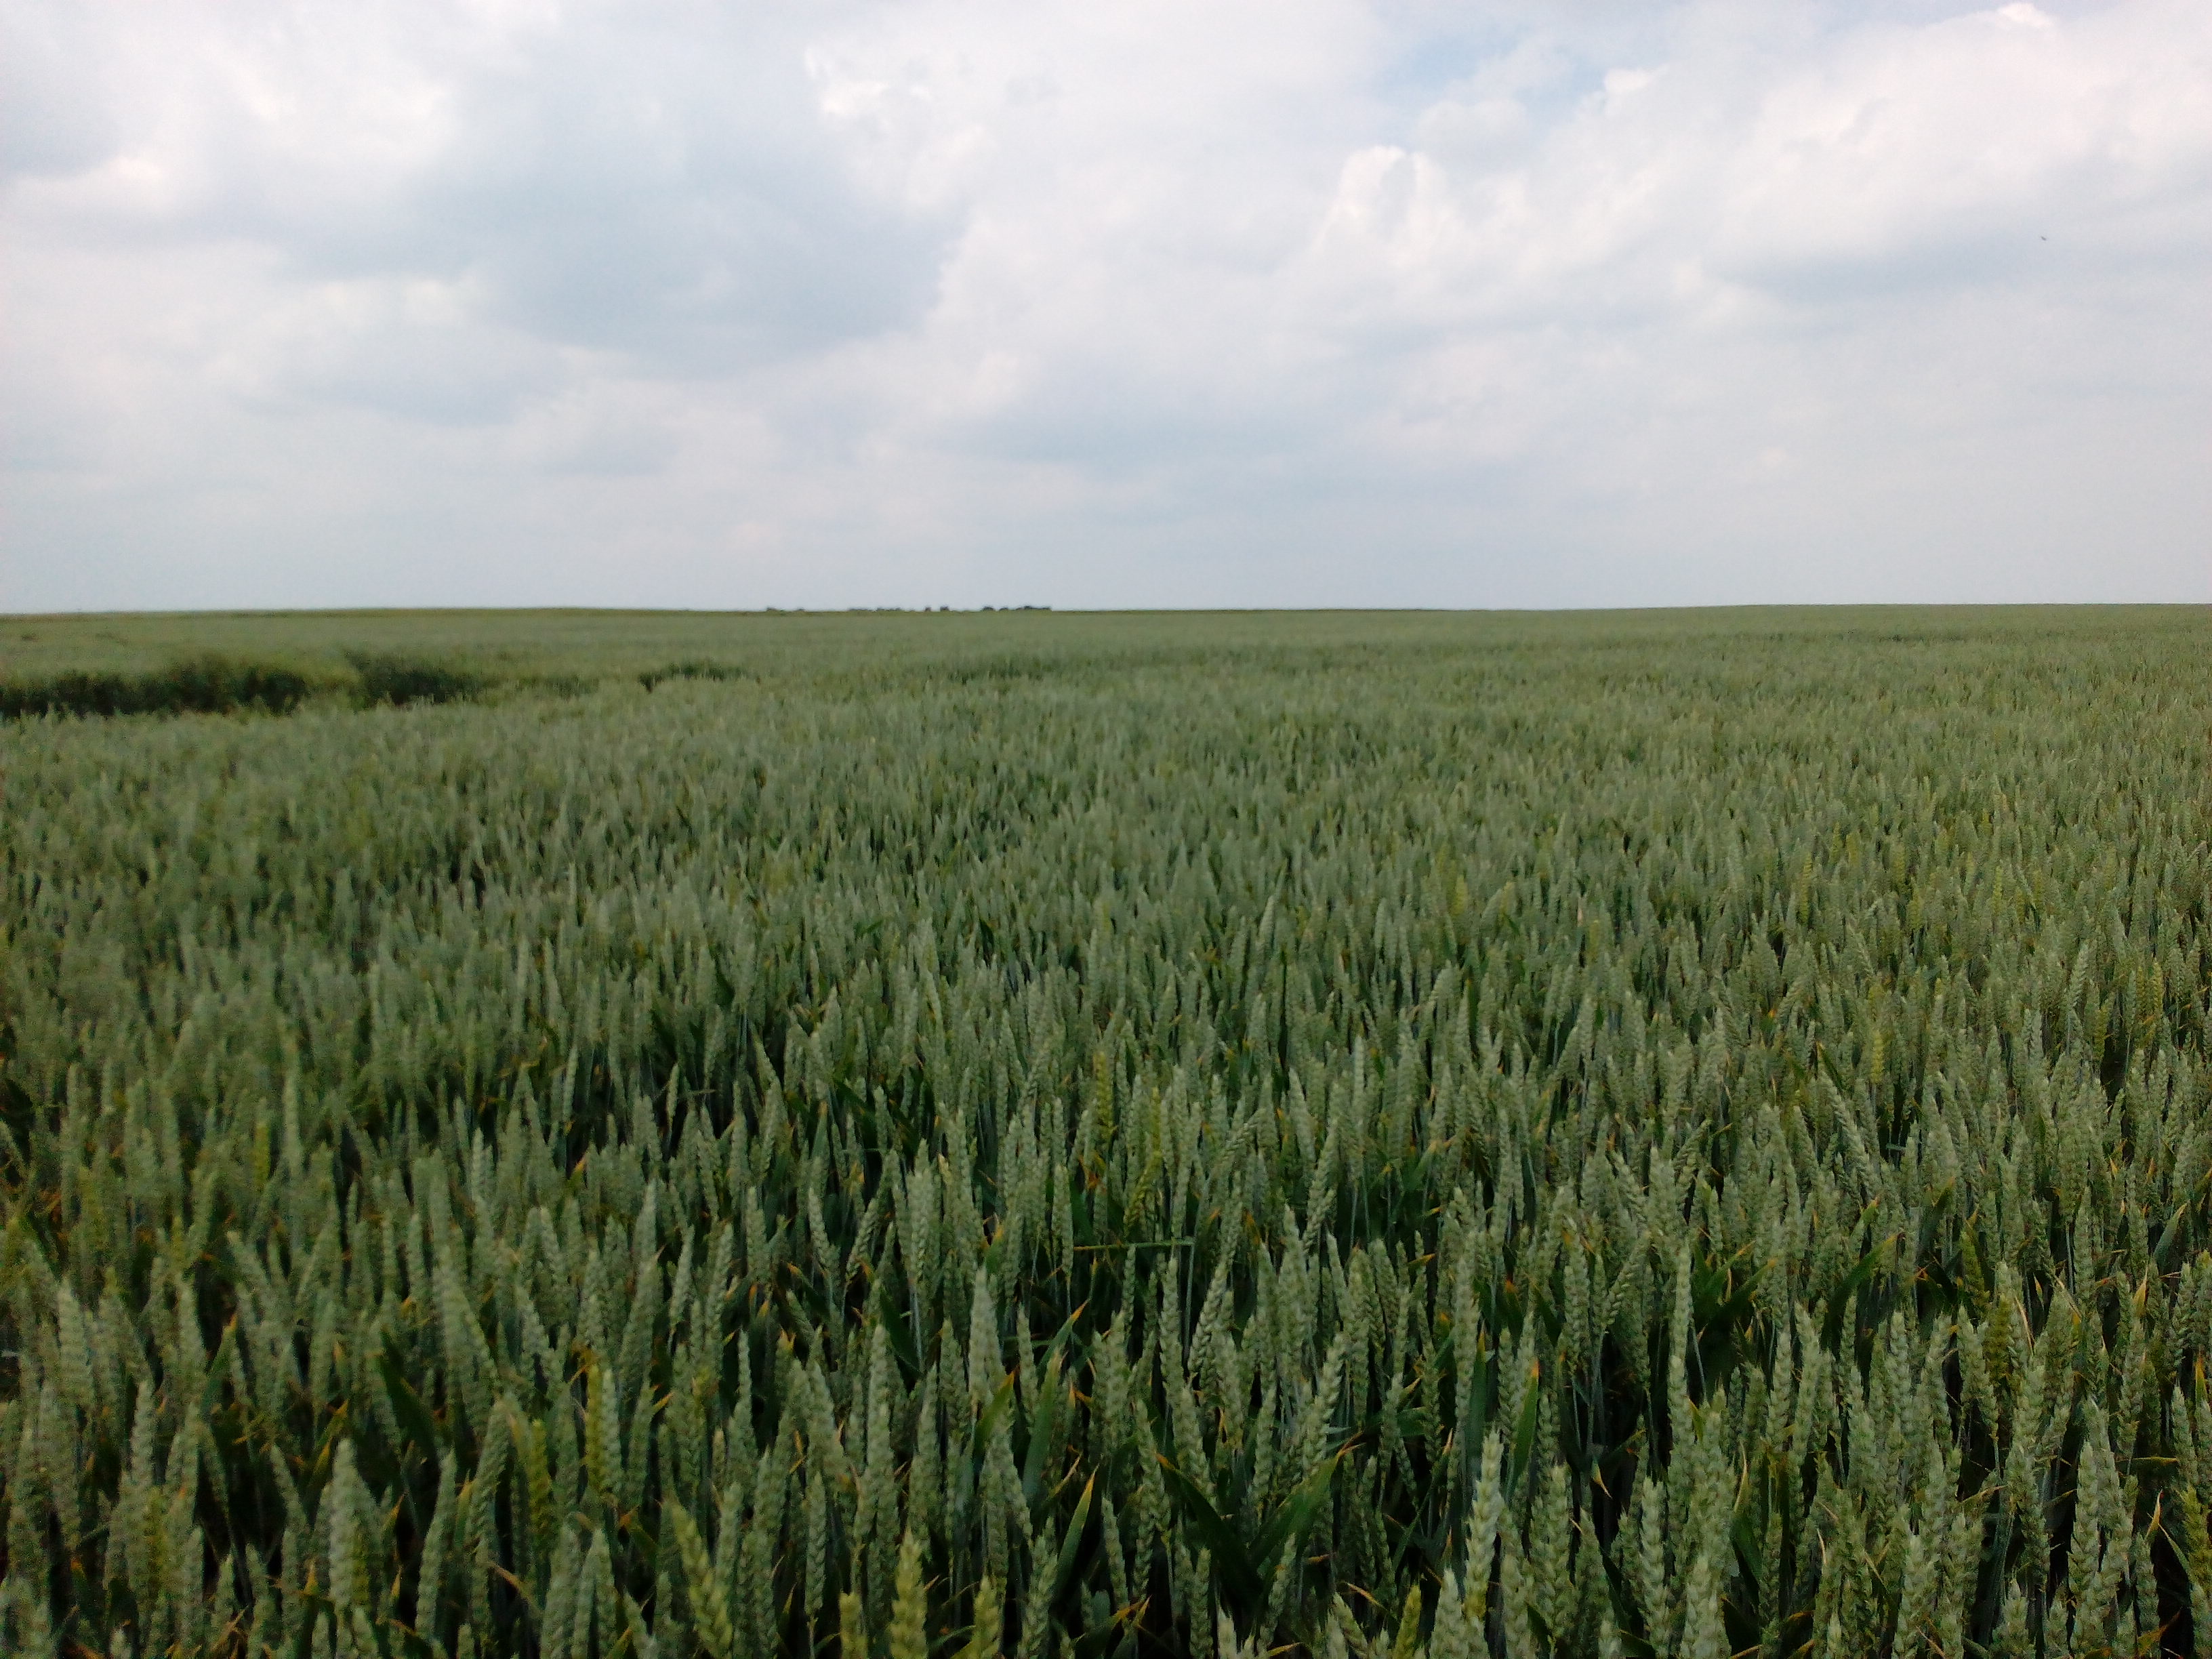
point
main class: Cropland
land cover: Common wheat
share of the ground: > 75 %
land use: Agriculture (excluding fallow land and kitchen gardens)
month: June
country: DE
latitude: 51.2398
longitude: 11.1026
